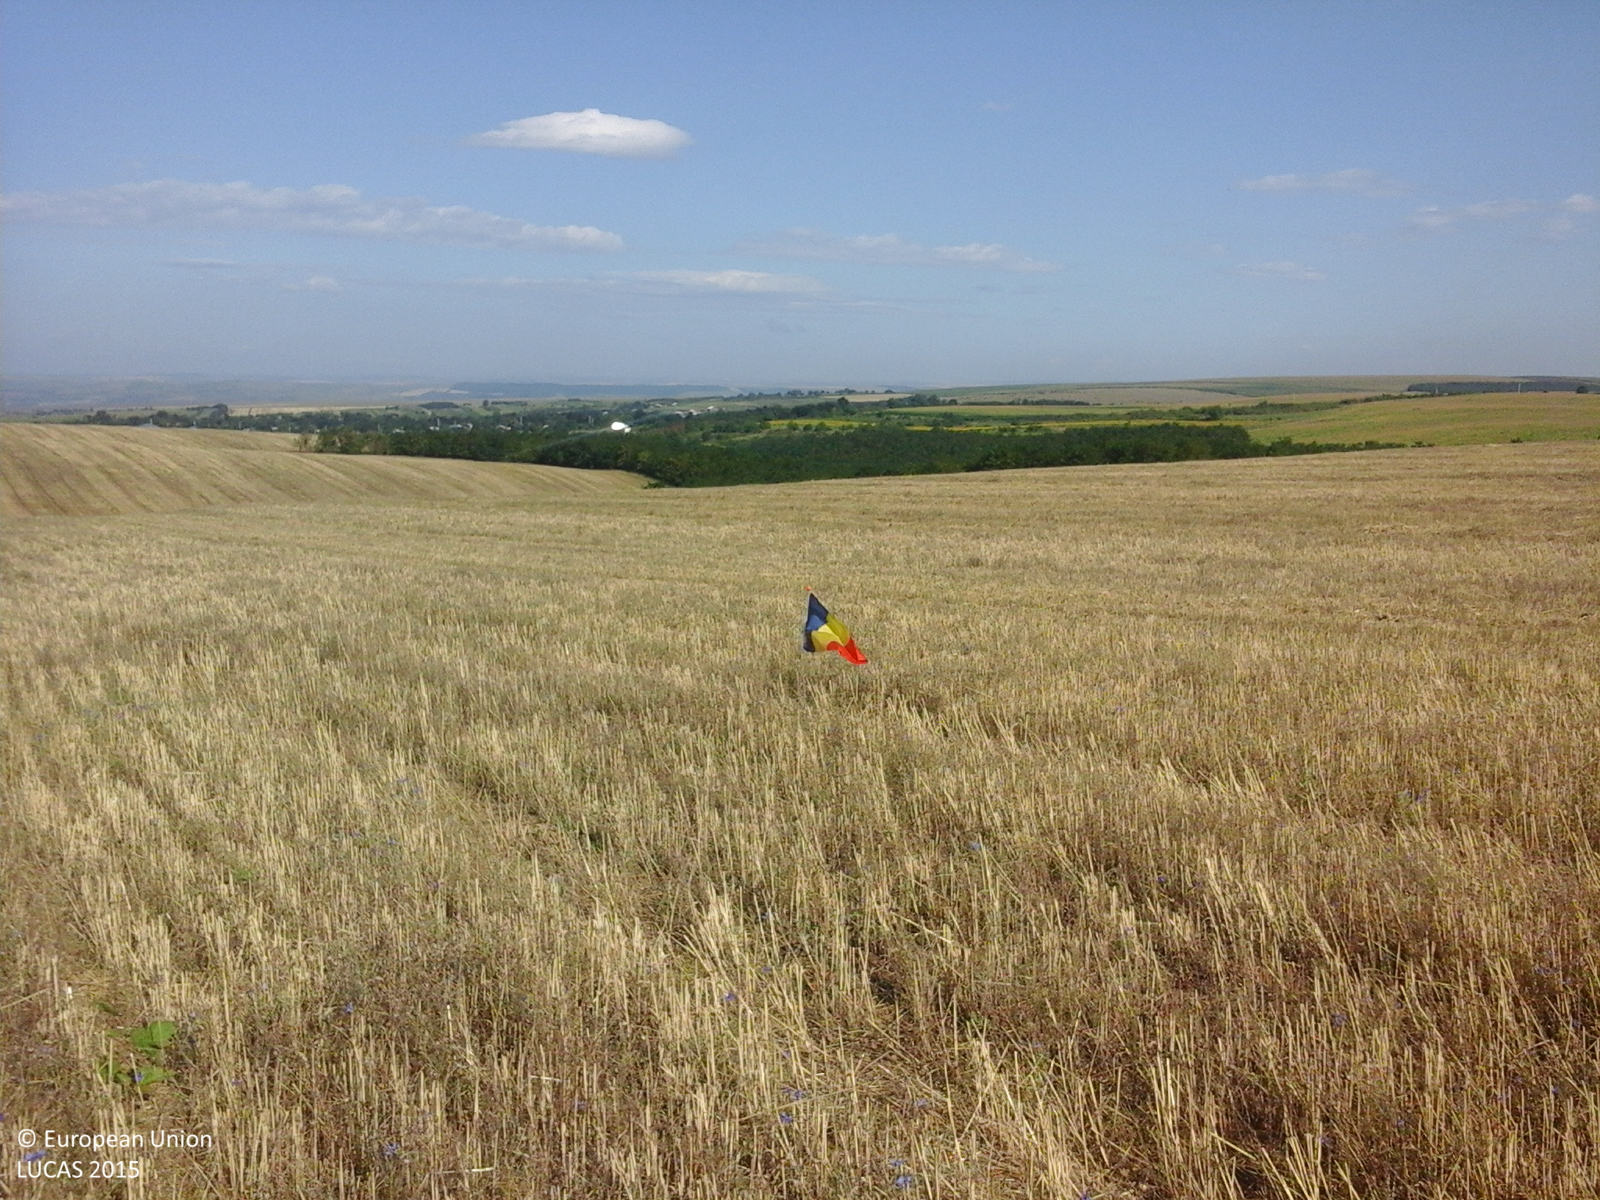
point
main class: Cropland
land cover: Common wheat
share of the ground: > 75 %
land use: Agriculture (excluding fallow land and kitchen gardens)
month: July
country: RO
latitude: 46.0956
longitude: 27.6916
